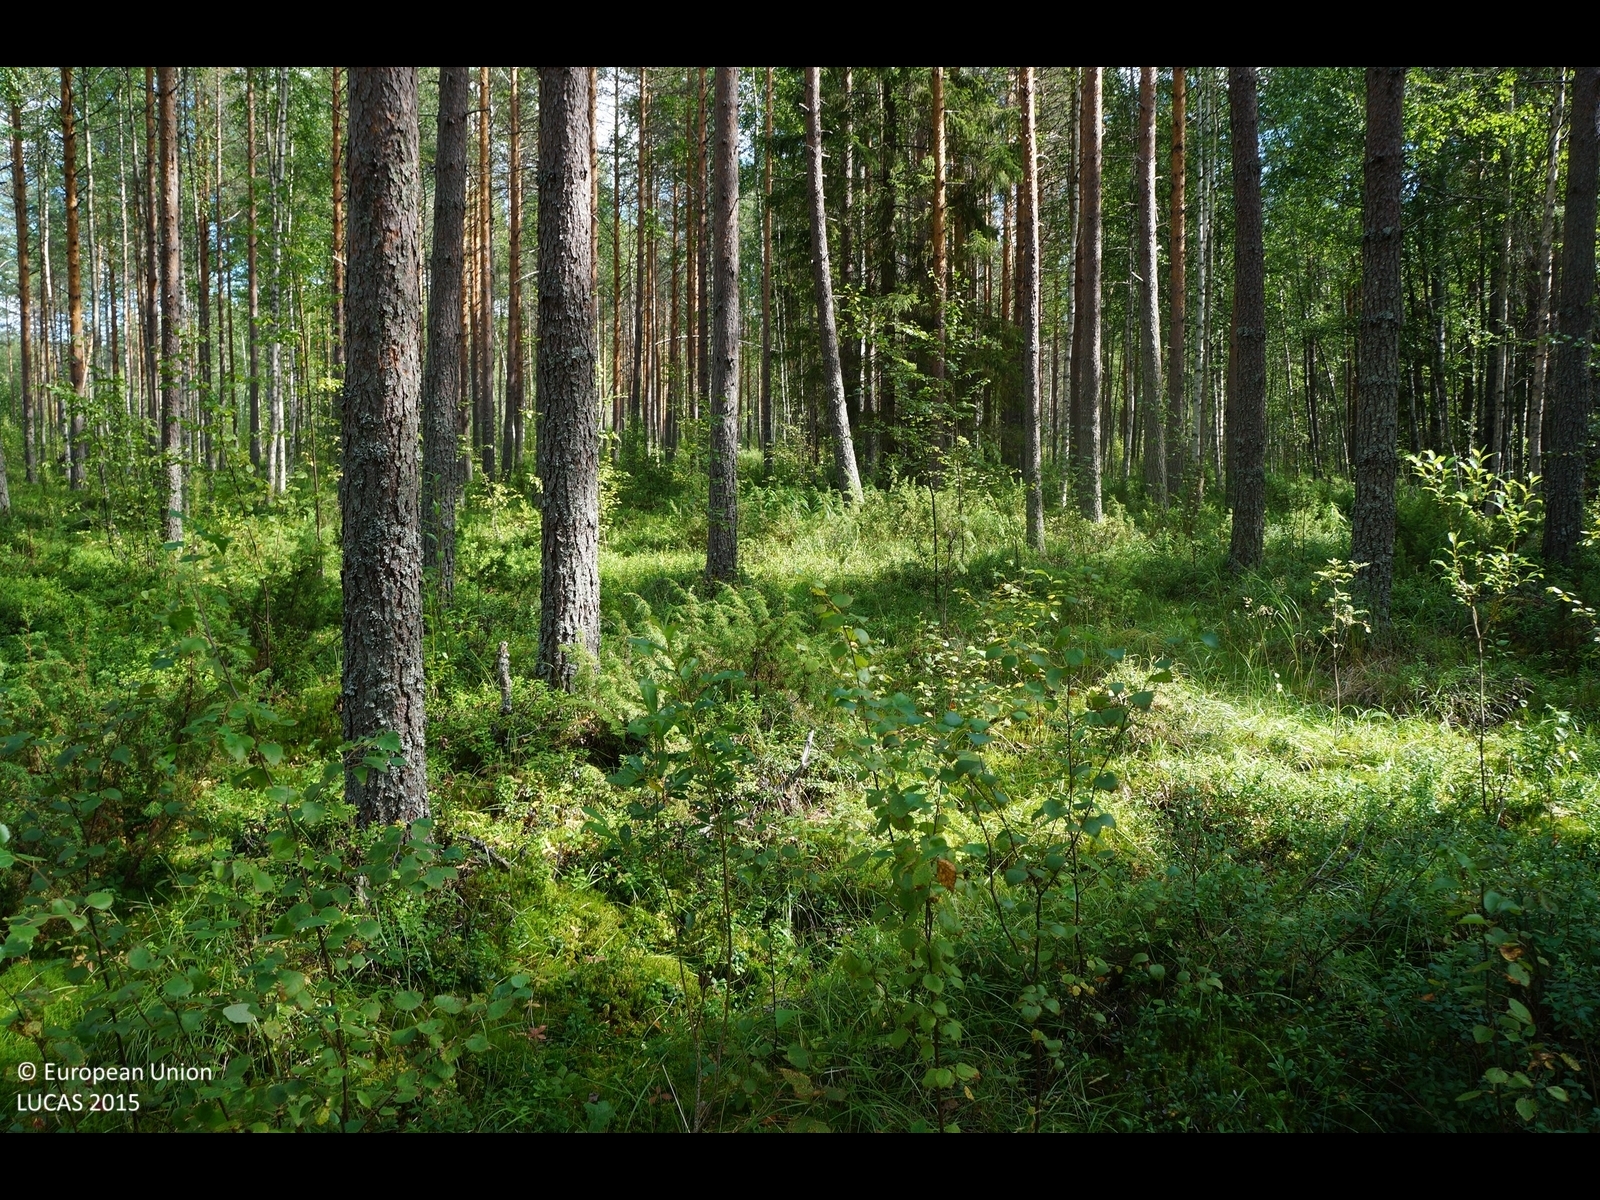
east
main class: Woodland
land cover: Pine dominated coniferous woodland
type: boreal forest
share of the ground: 50 - 75 %
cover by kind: coniferous forest trees 55 %, shrubs 20 %, lichens and mosses 15 %, herbaceous plants 10 %
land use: Forestry
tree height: > 5 m
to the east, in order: Pine dominated coniferous woodland; Pine dominated mixed woodland; Ditches and canals; Pine dominated mixed woodland; Pine dominated coniferous woodland; Broadleaved woodland; Ditches and canals; Broadleaved woodland; Paved roads, cycling and walking lanes; Broadleaved woodland; Ditches and canals; Broadleaved woodland; Ditches and canals; Broadleaved woodland
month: August
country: FI
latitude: 64.4096
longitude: 26.0186
